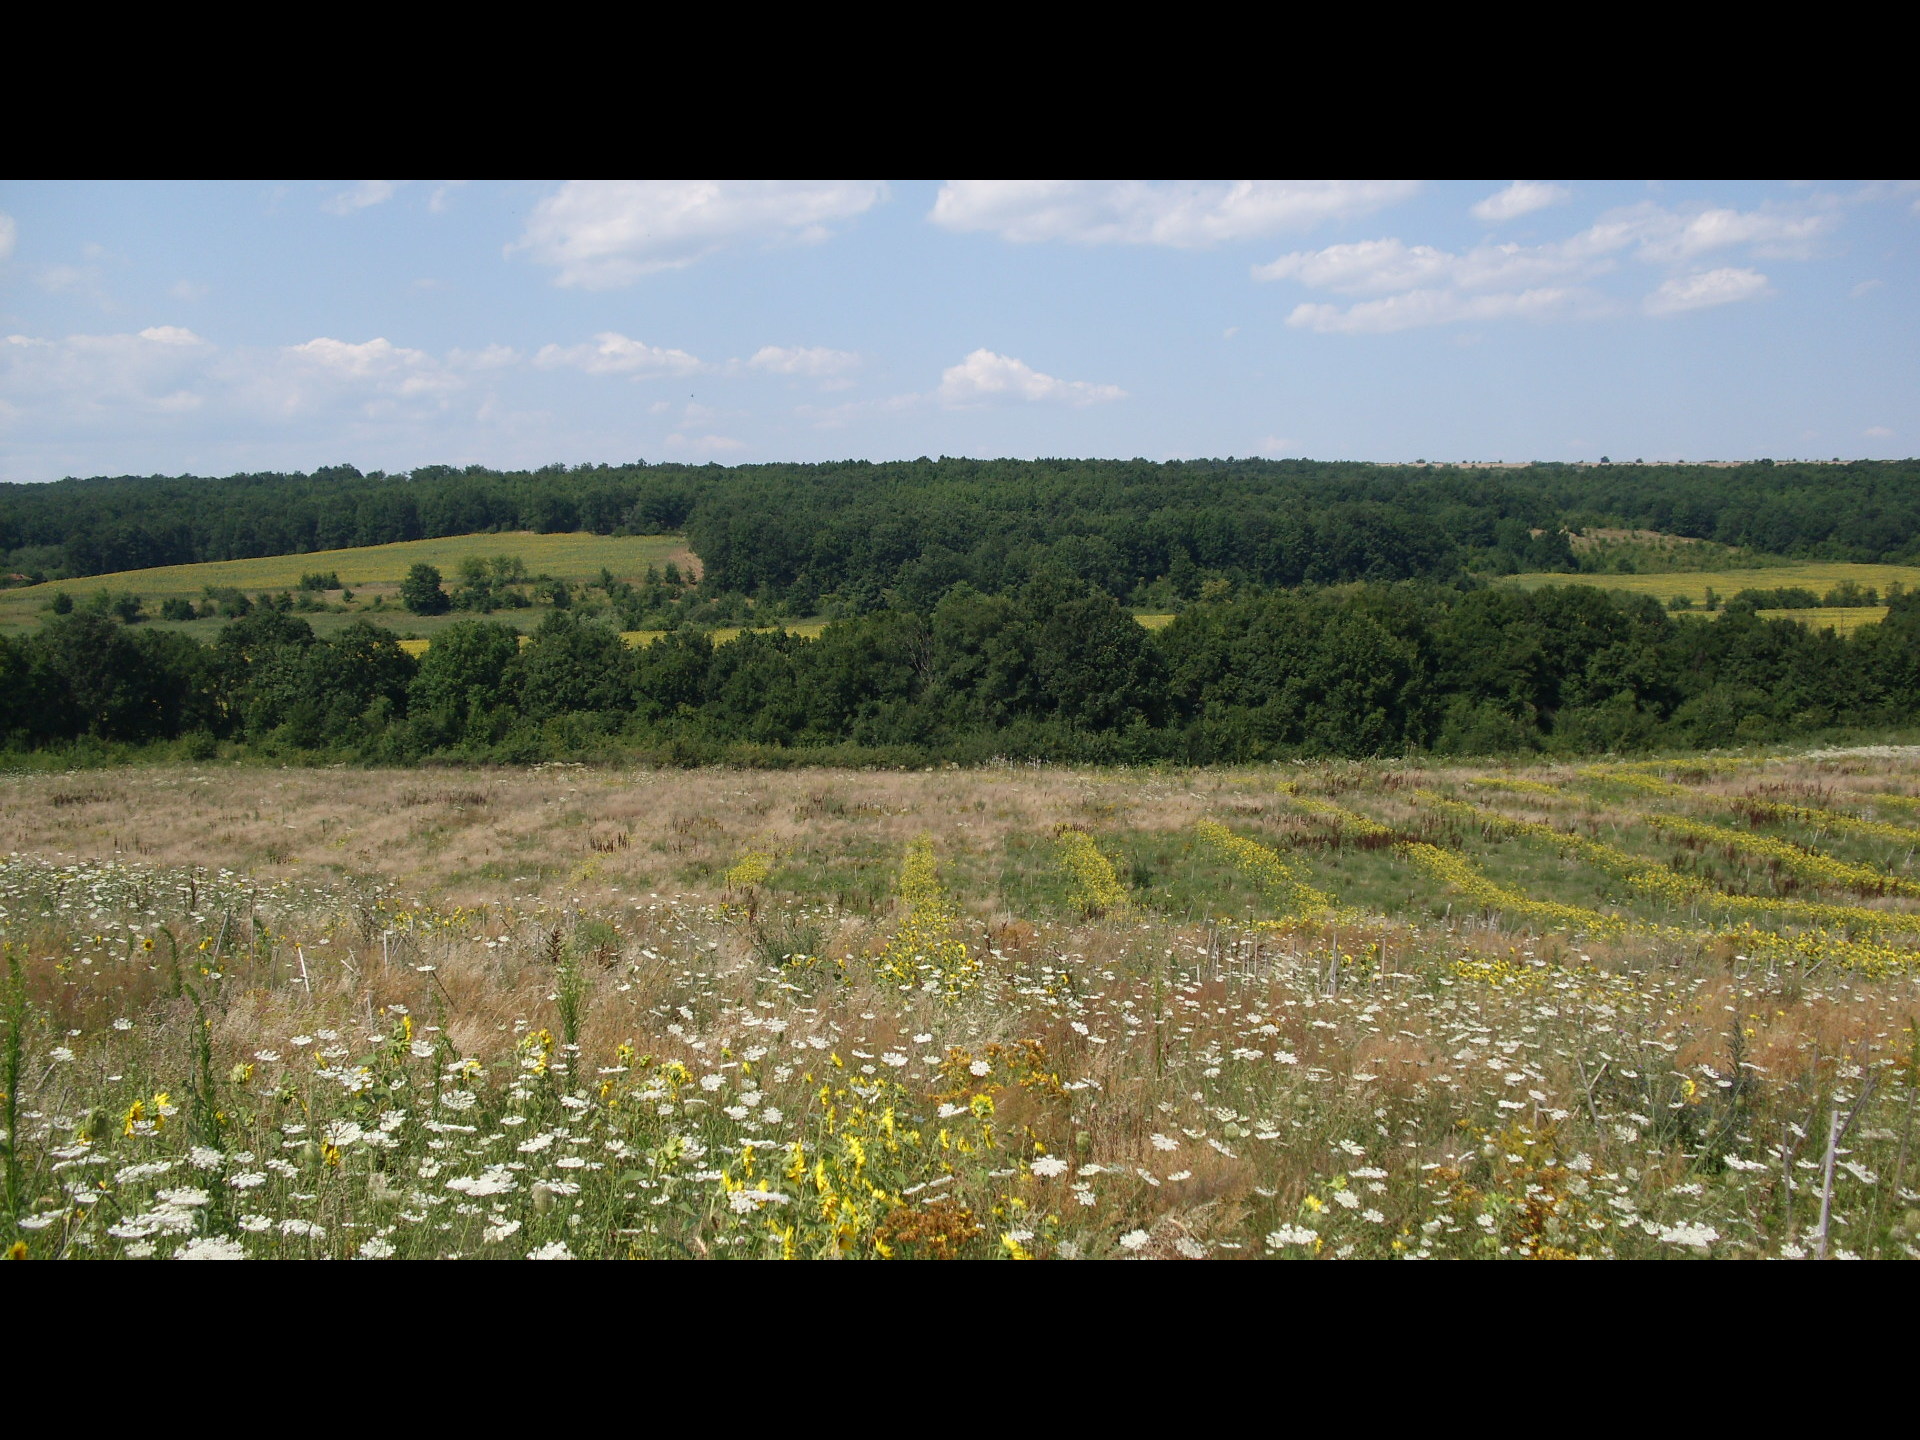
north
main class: Grassland
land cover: Spontaneously vegetated surfaces
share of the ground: > 75 %
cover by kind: herbaceous plants 100 %
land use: Fallow land
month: July
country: BG
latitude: 43.7625
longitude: 22.5918
